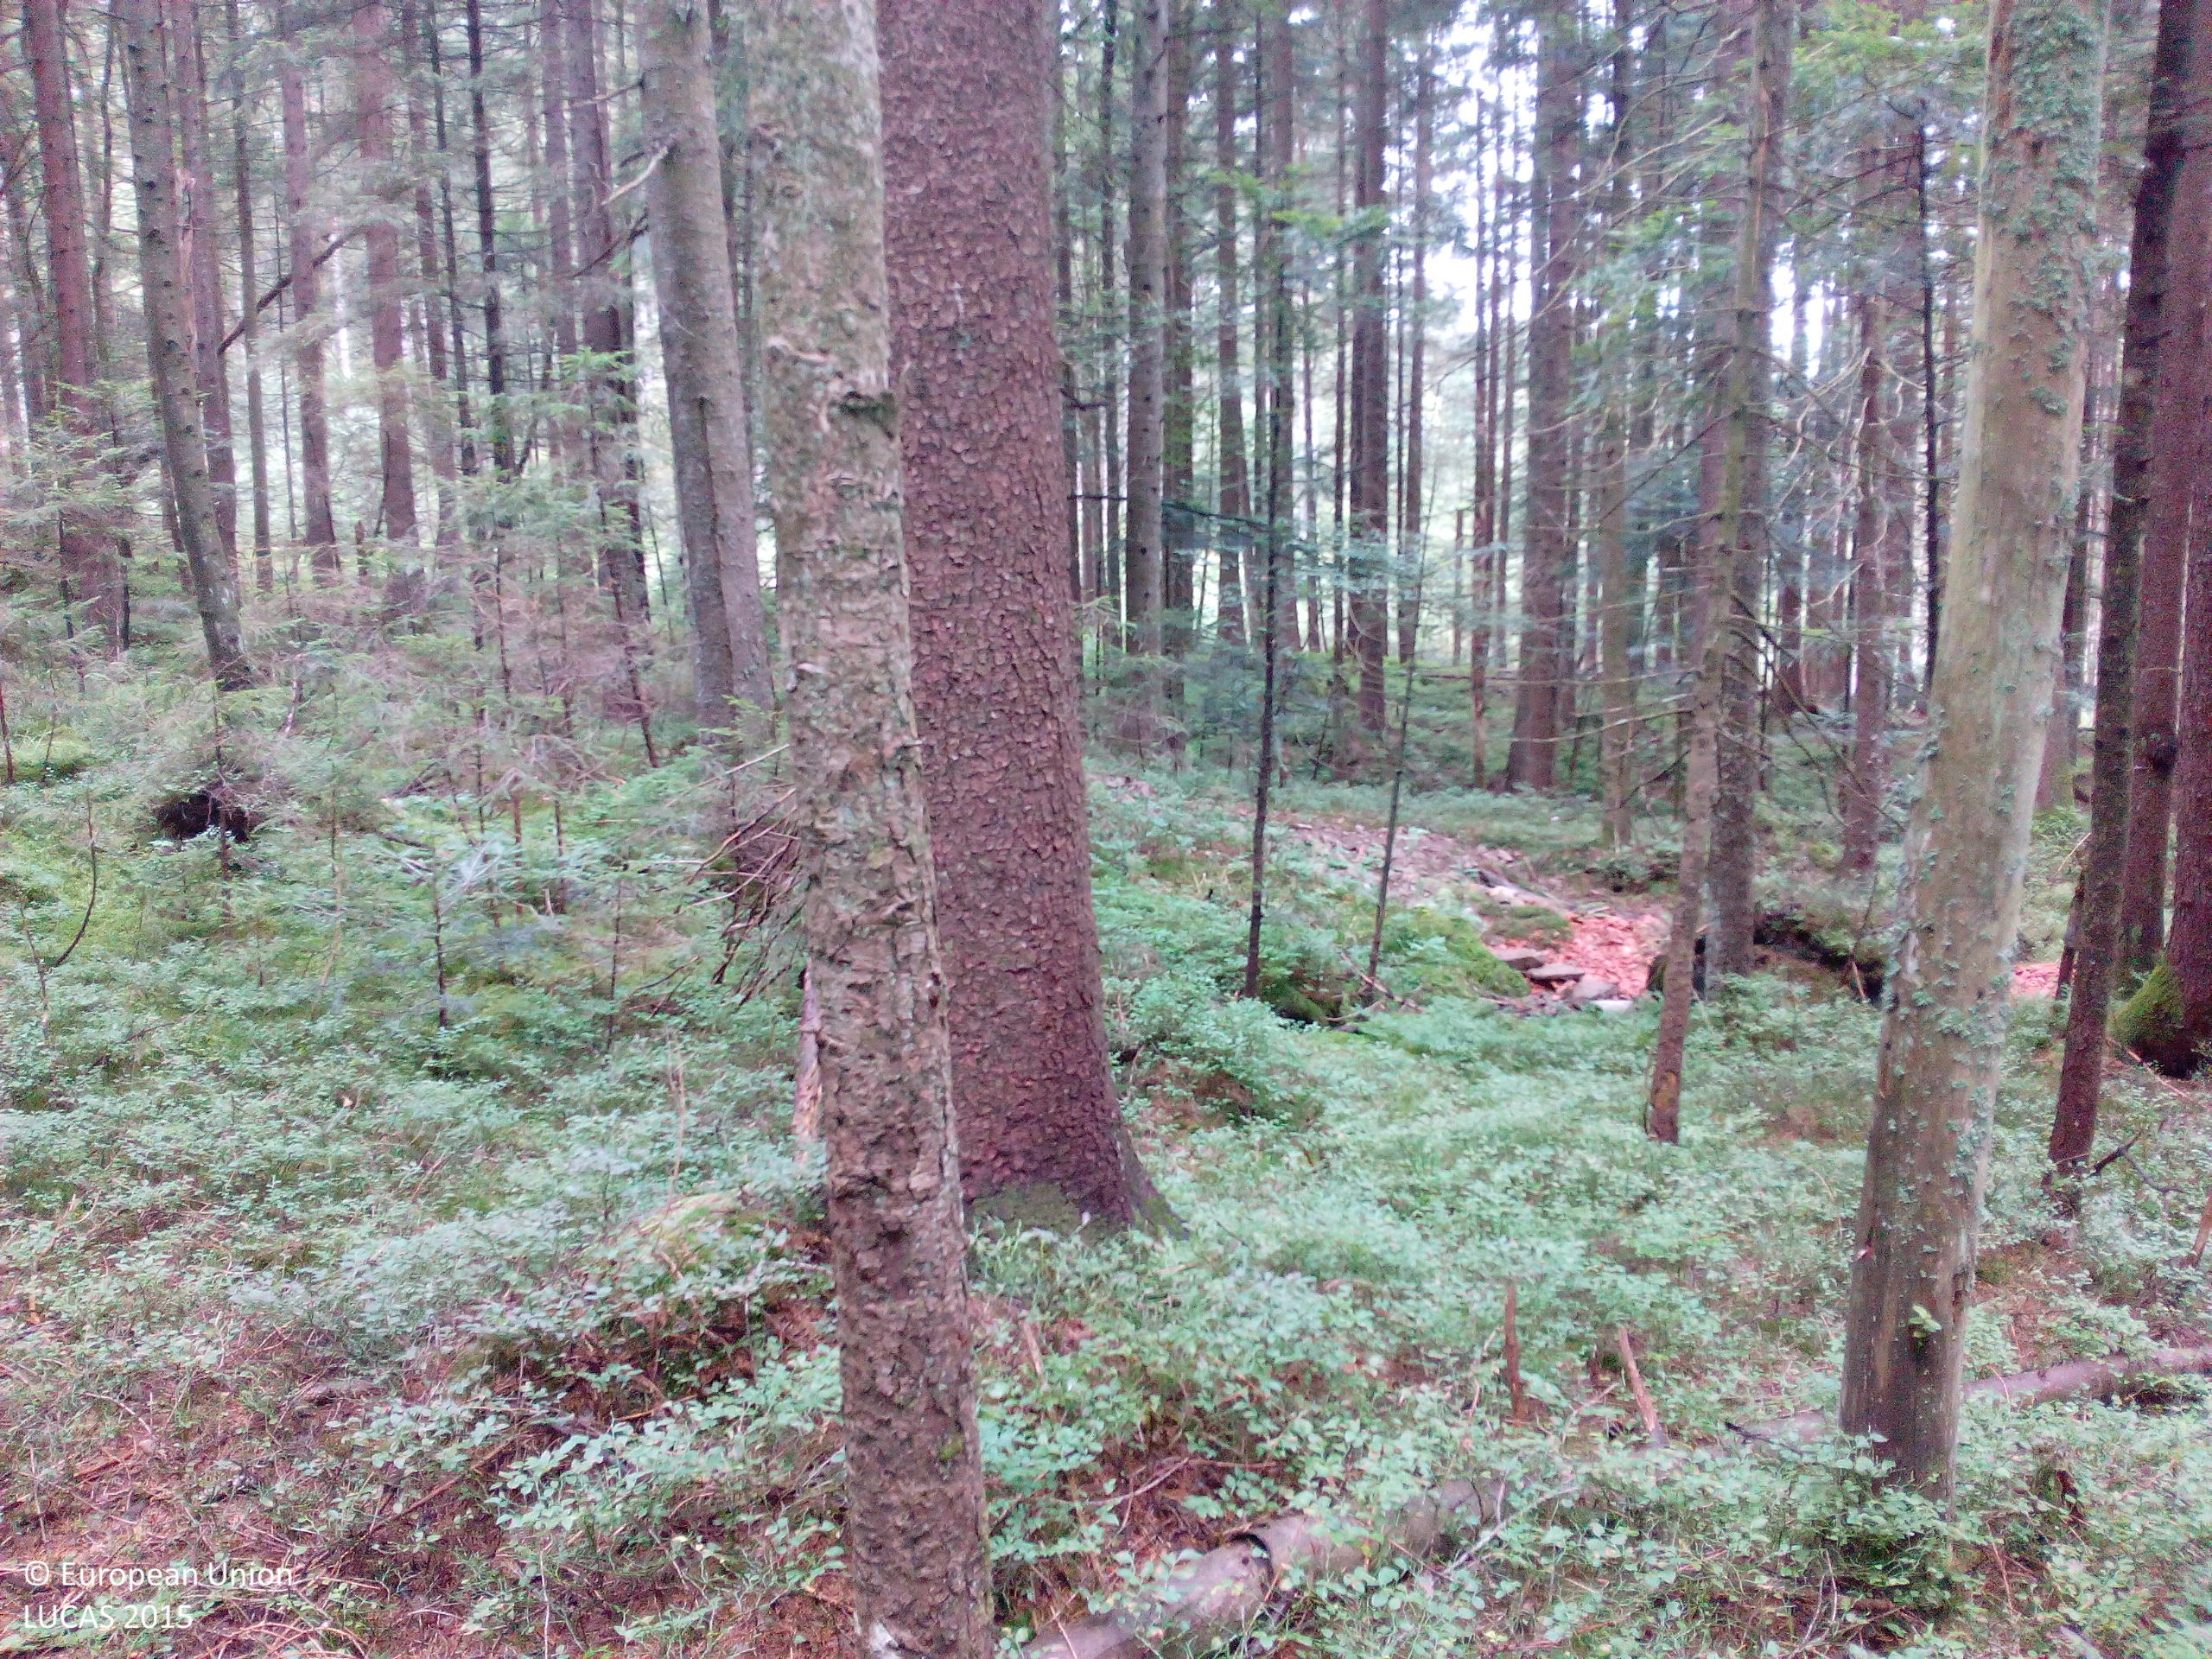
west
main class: Woodland
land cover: Spruce dominated coniferous woodland
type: hemiboreal forest and nemoral coniferous forest and mixed broadleaved-coniferous forest
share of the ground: > 75 %
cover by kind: coniferous forest trees 75 %, shrubs 15 %, unconsolidated bare surface 10 %
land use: Forestry
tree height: > 5 m
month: September
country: DE
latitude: 48.9586
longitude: 12.9359
